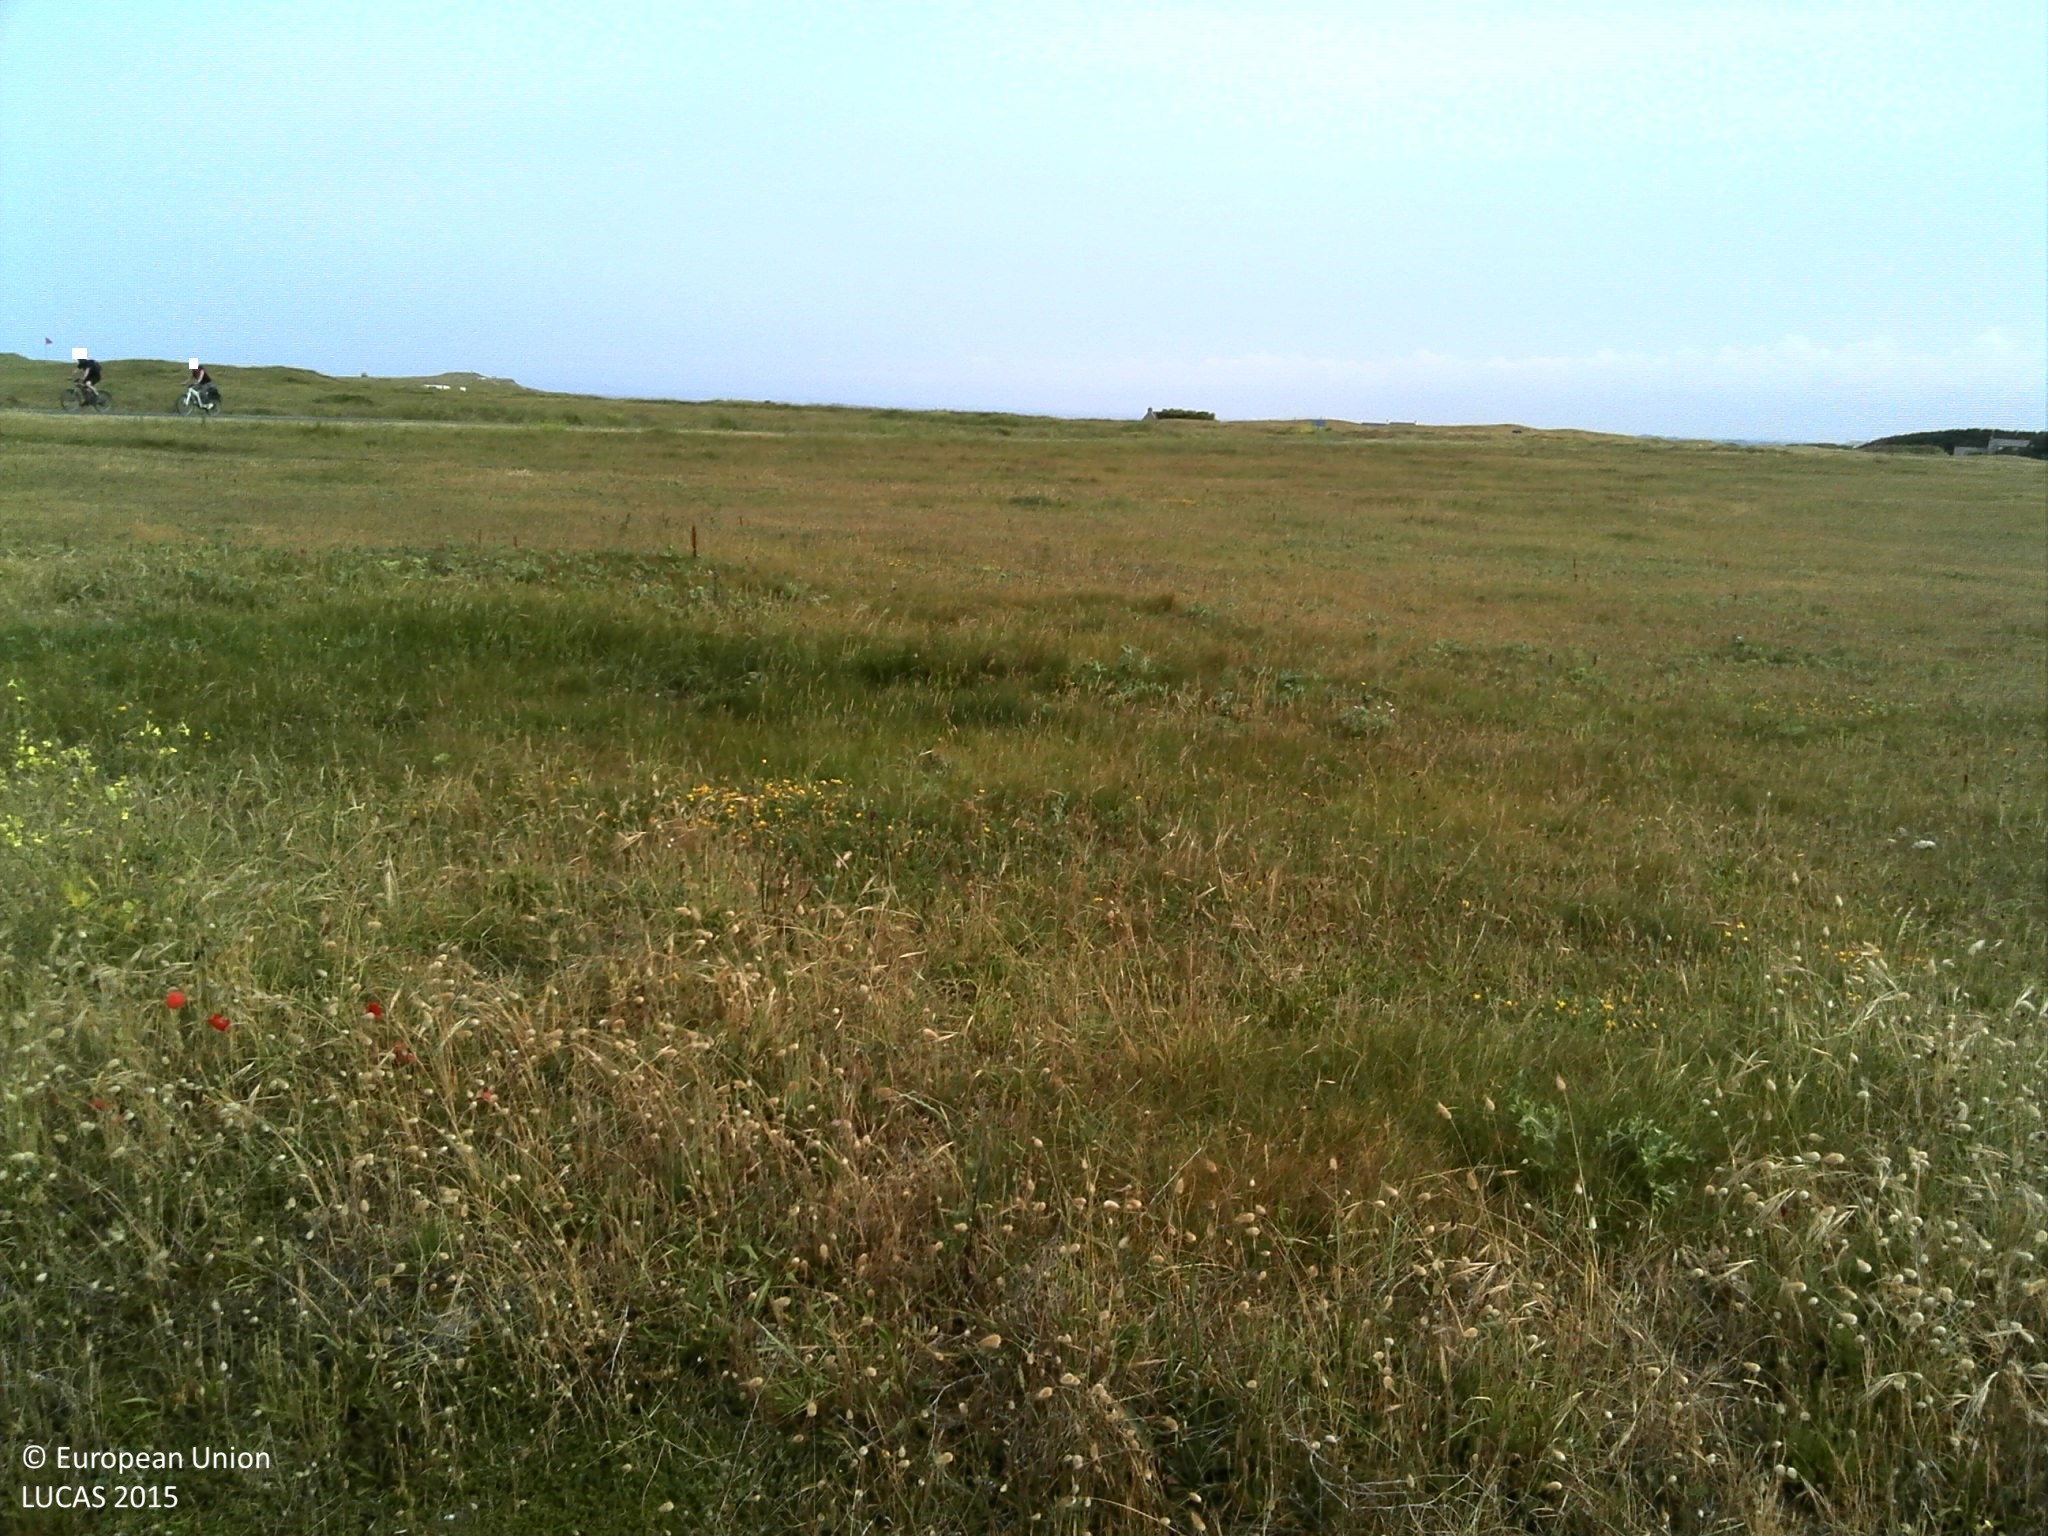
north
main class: Grassland
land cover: Grassland without tree/shrub cover
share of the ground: > 75 %
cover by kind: herbaceous plants 100 %
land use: Agriculture (excluding fallow land and kitchen gardens)
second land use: Amenities, museums, leisure
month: June
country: FR
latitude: 47.8273
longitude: -4.3454
